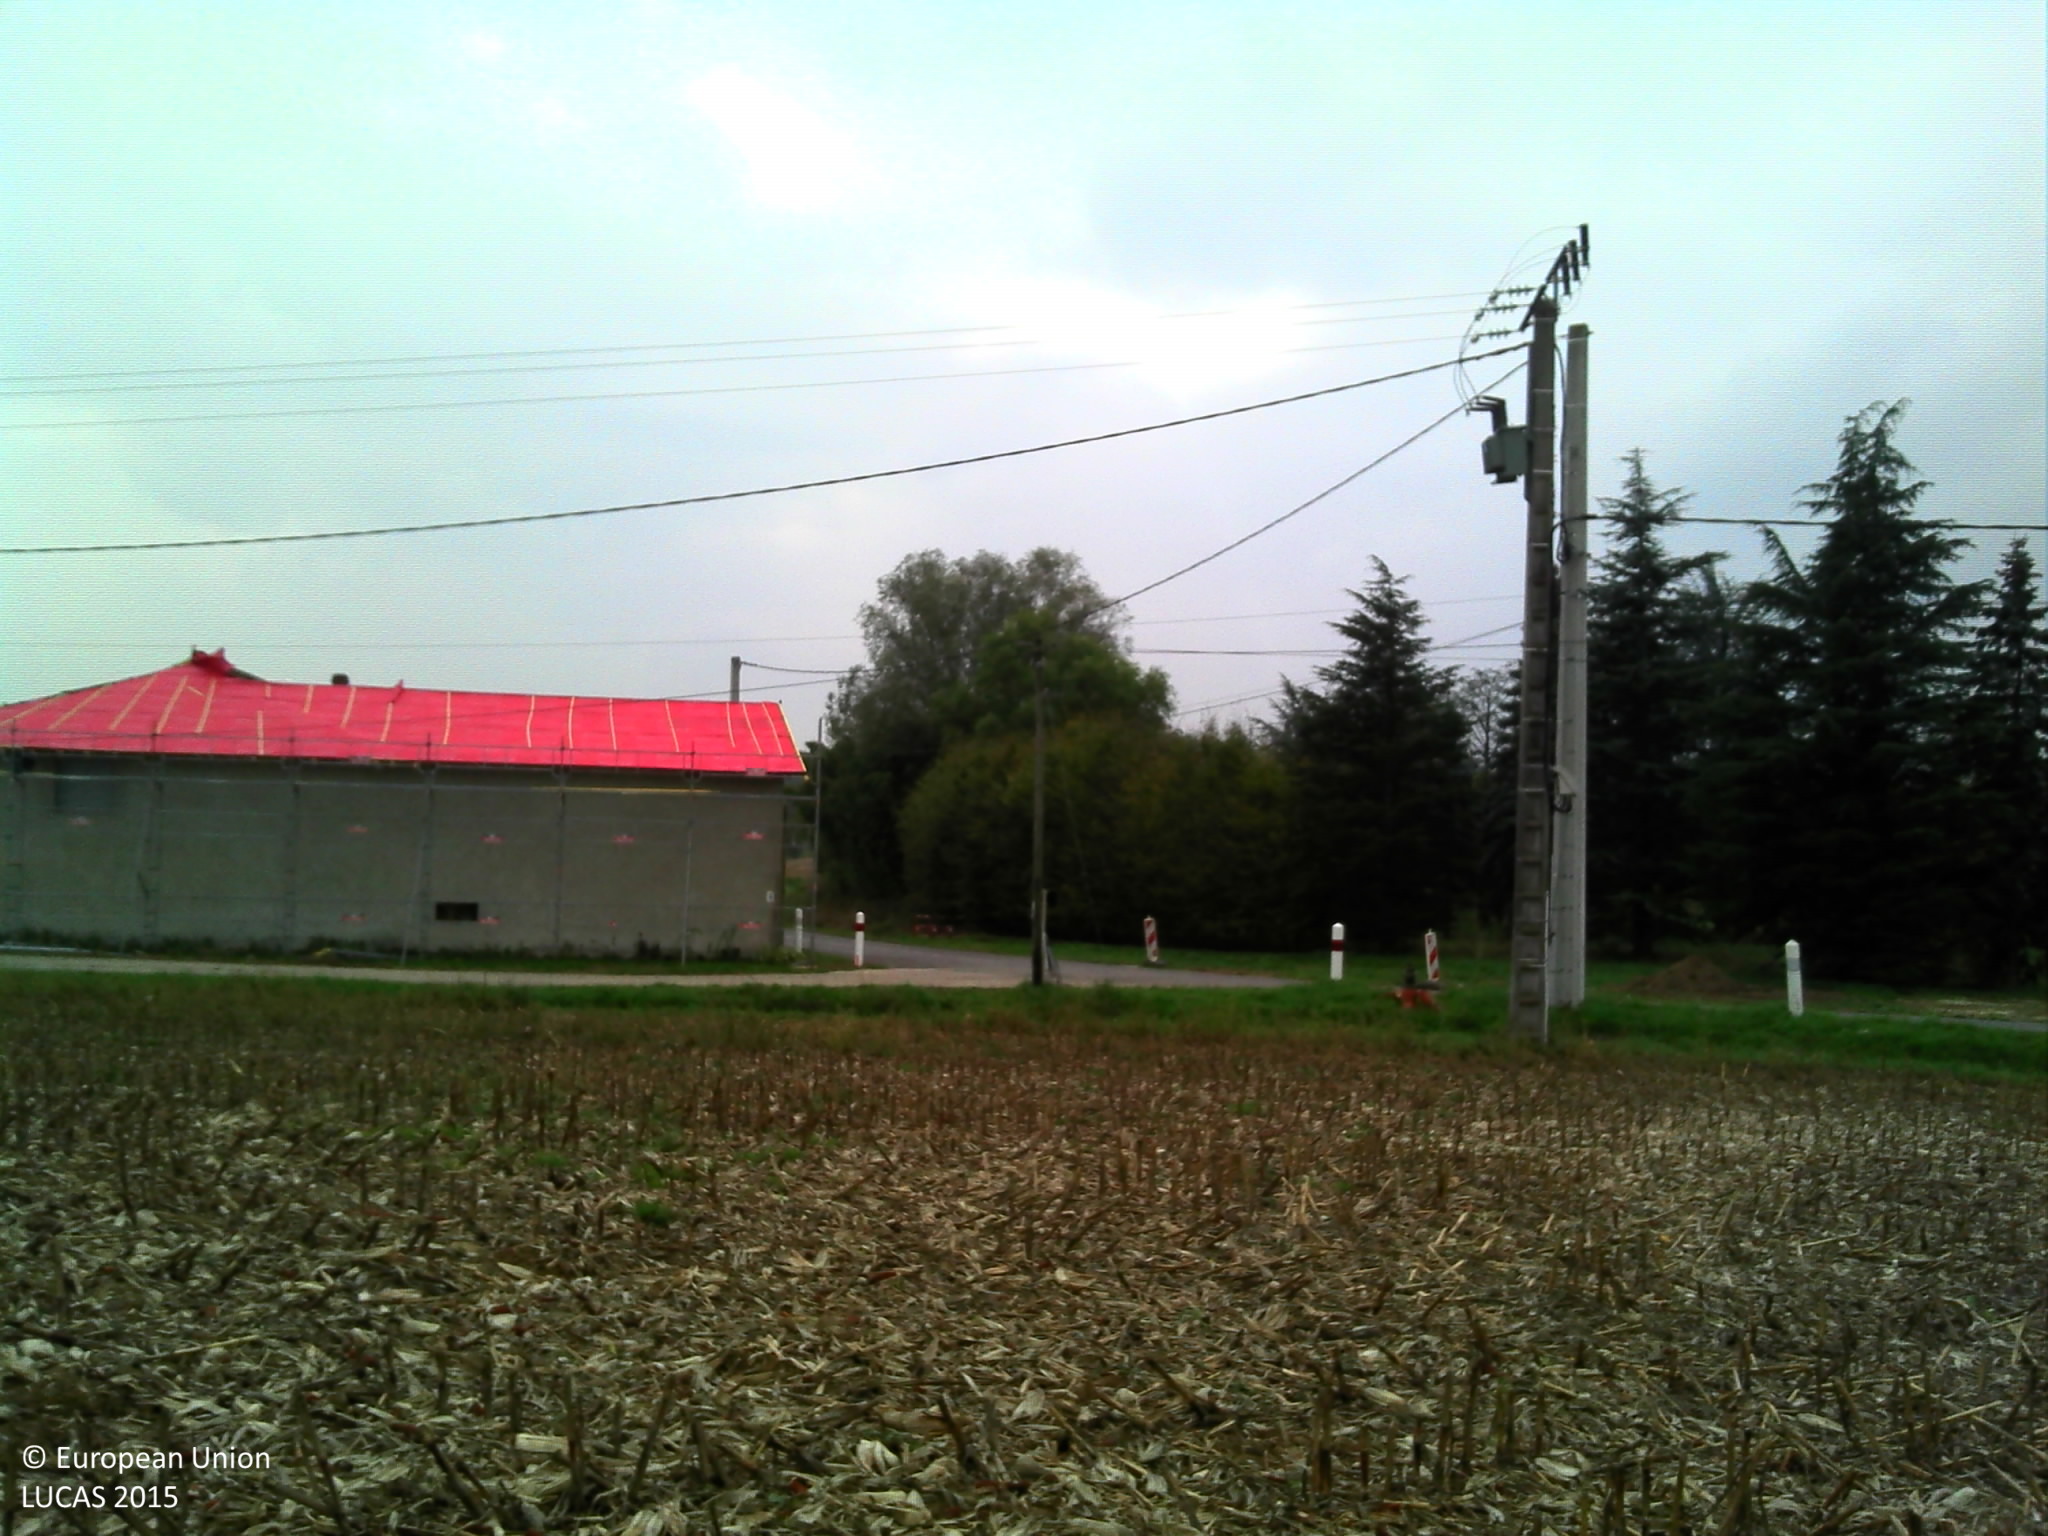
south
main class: Cropland
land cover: Maize
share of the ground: < 10 %
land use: Agriculture (excluding fallow land and kitchen gardens)
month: October
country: FR
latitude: 46.2923
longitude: 5.0829
